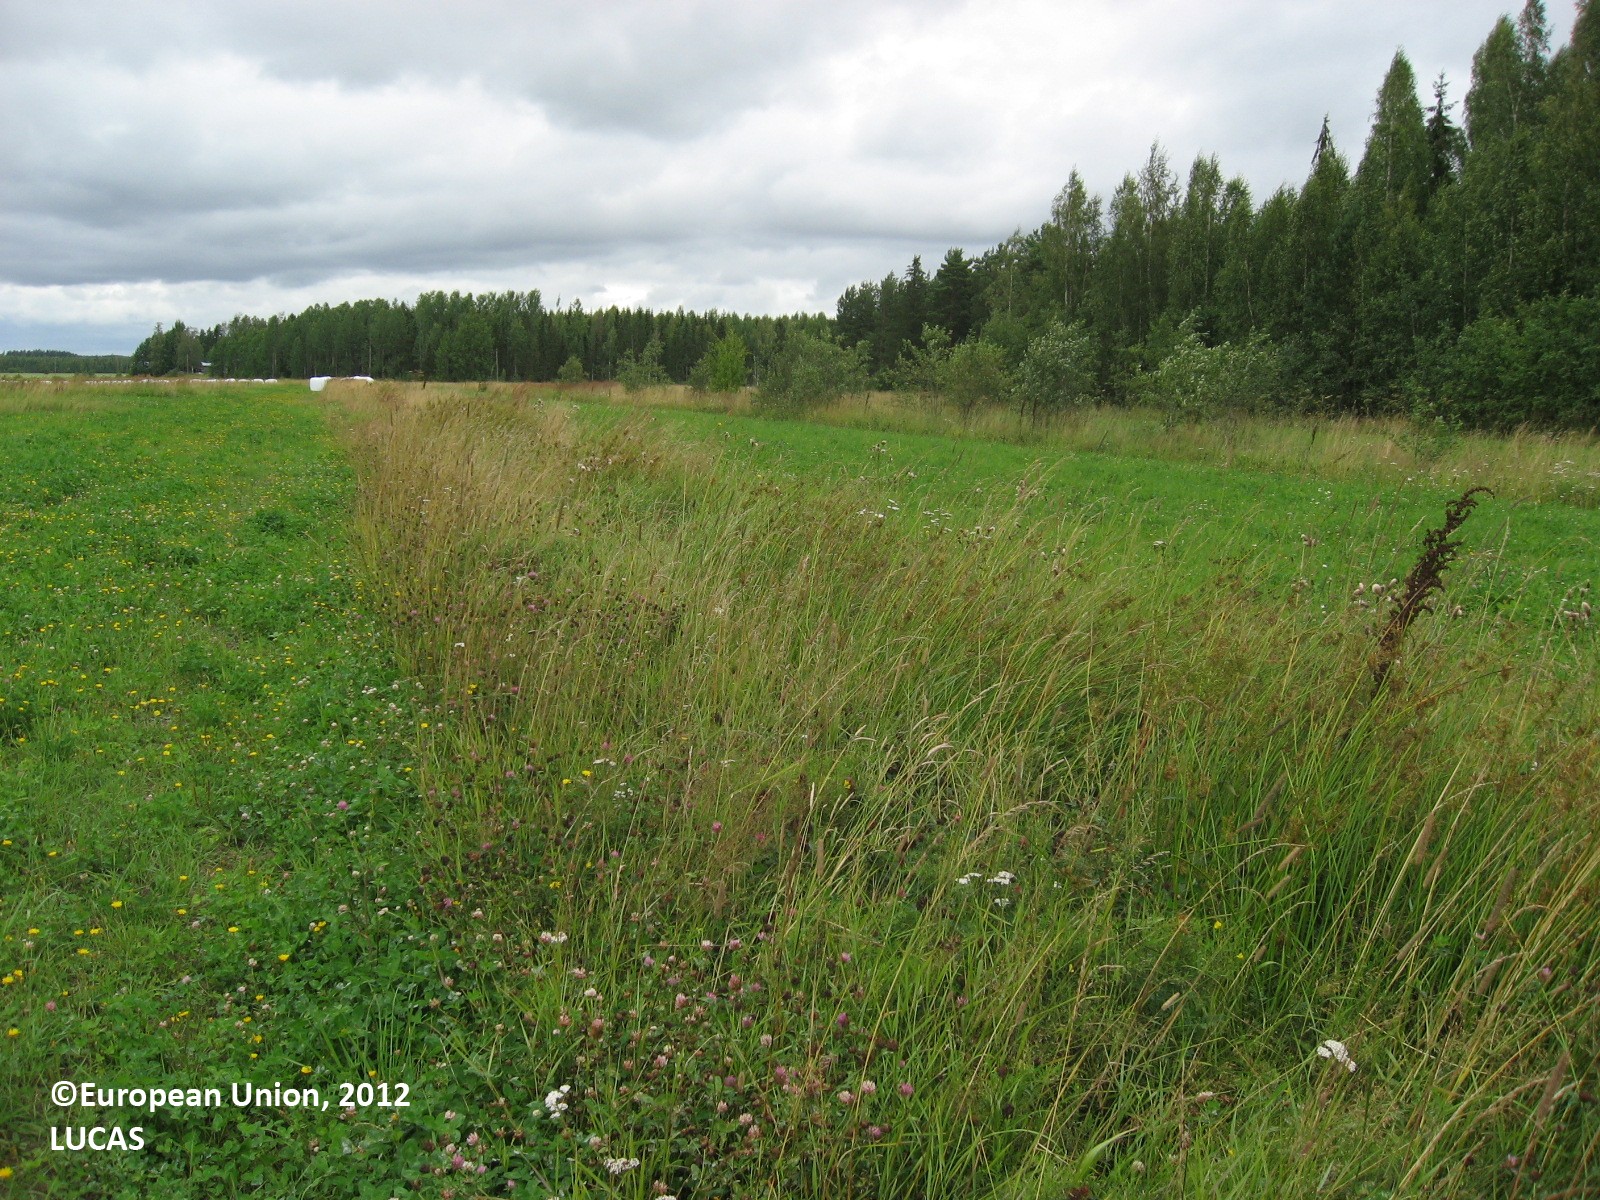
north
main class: Cropland
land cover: Clovers
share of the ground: > 75 %
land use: Agriculture (excluding fallow land and kitchen gardens)
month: August
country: FI
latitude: 60.6891
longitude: 25.5667
